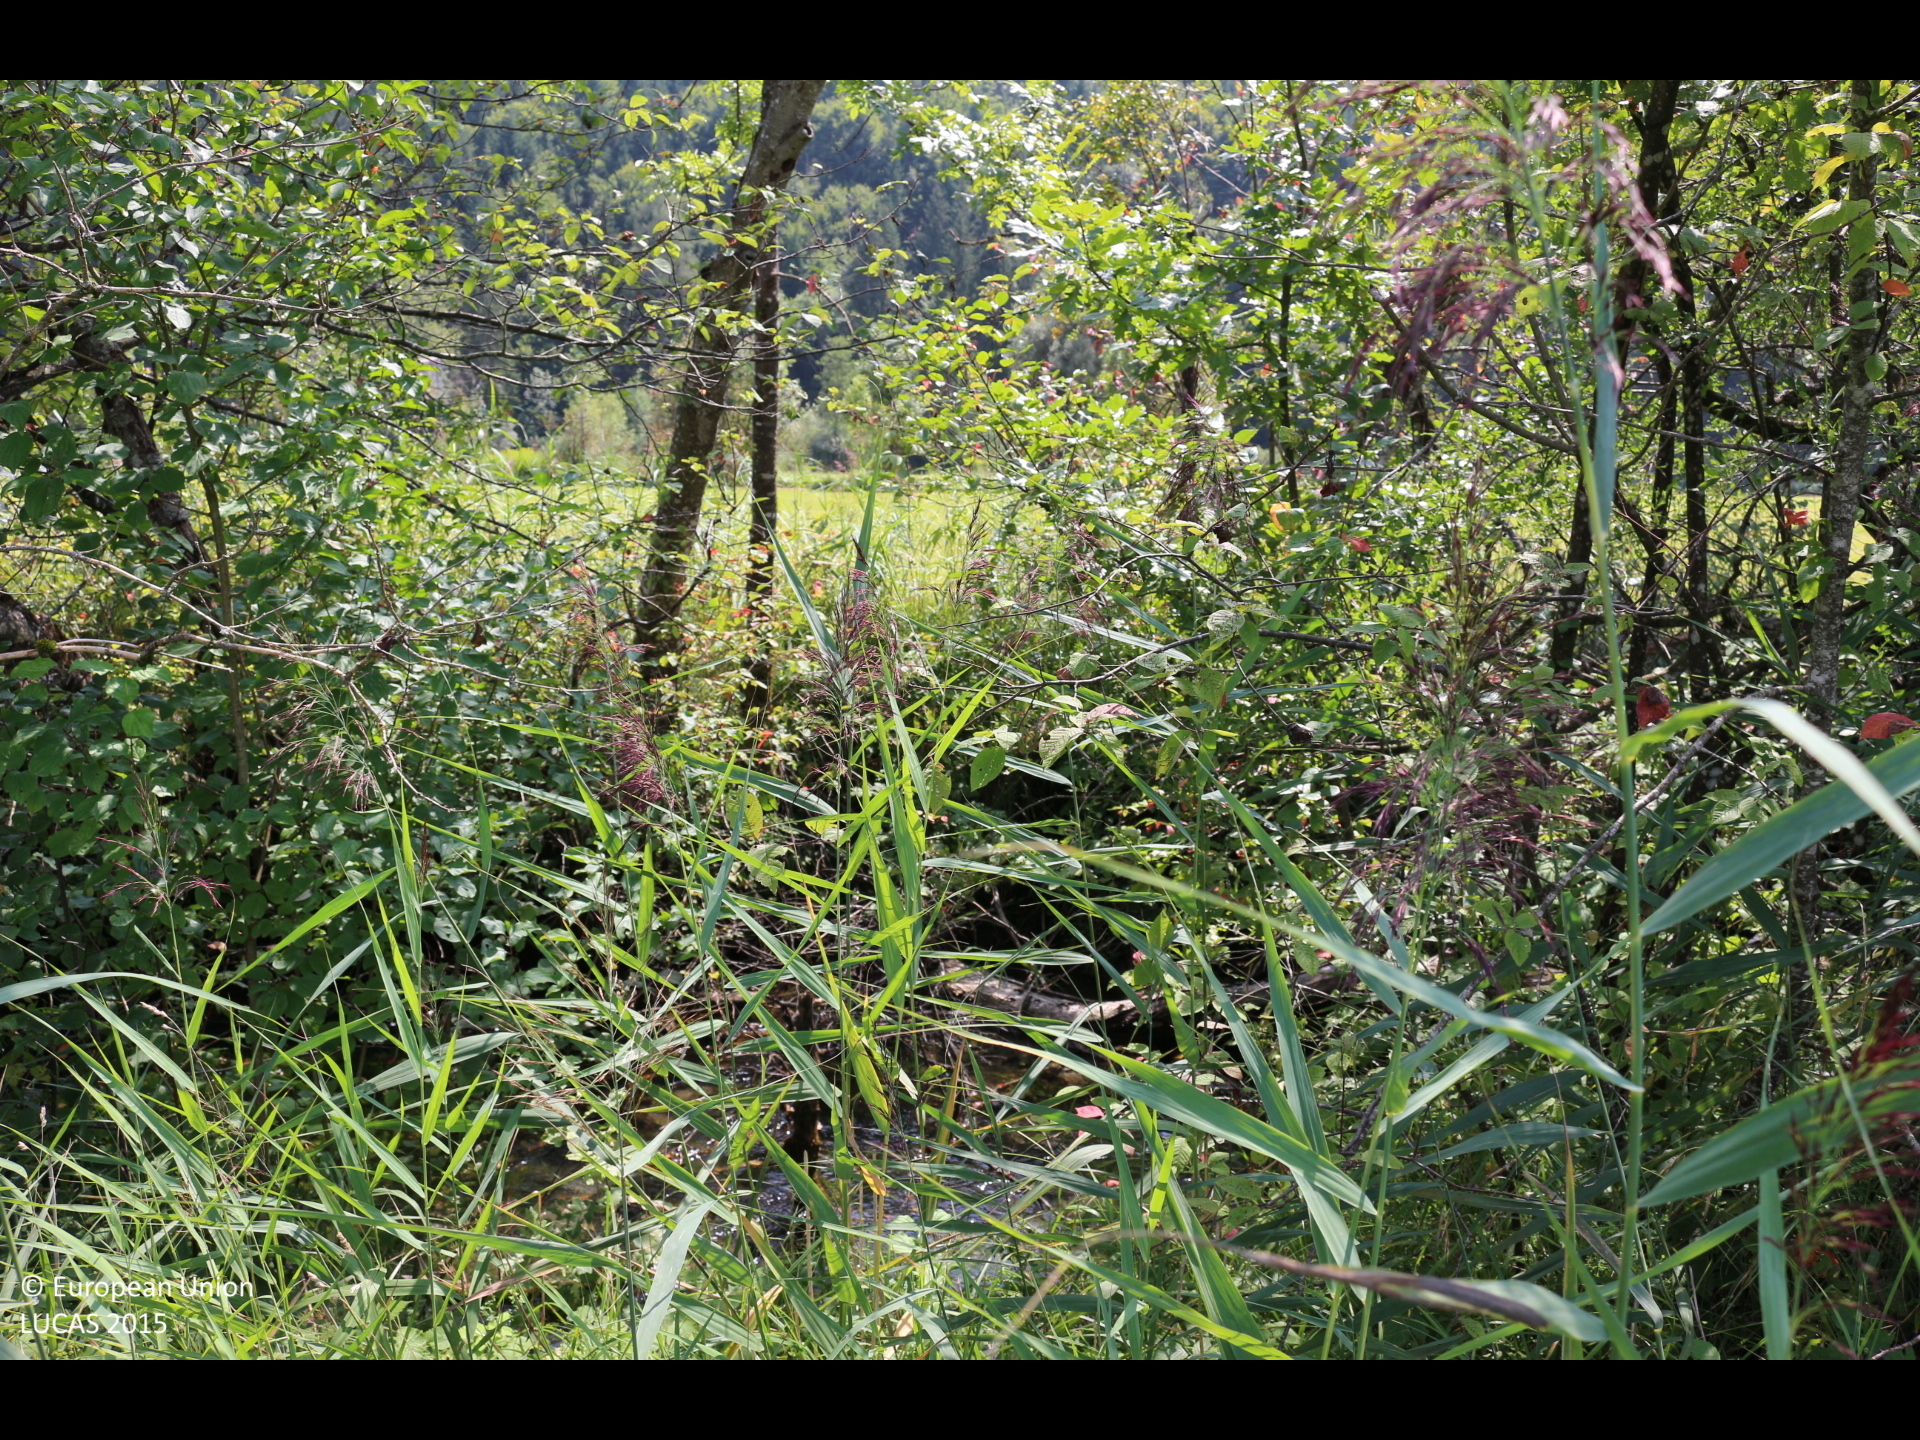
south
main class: Grassland
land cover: Grassland without tree/shrub cover
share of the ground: > 75 %
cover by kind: herbaceous plants 100 %
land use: Agriculture (excluding fallow land and kitchen gardens)
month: August
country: AT
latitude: 46.6035
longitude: 13.4045
